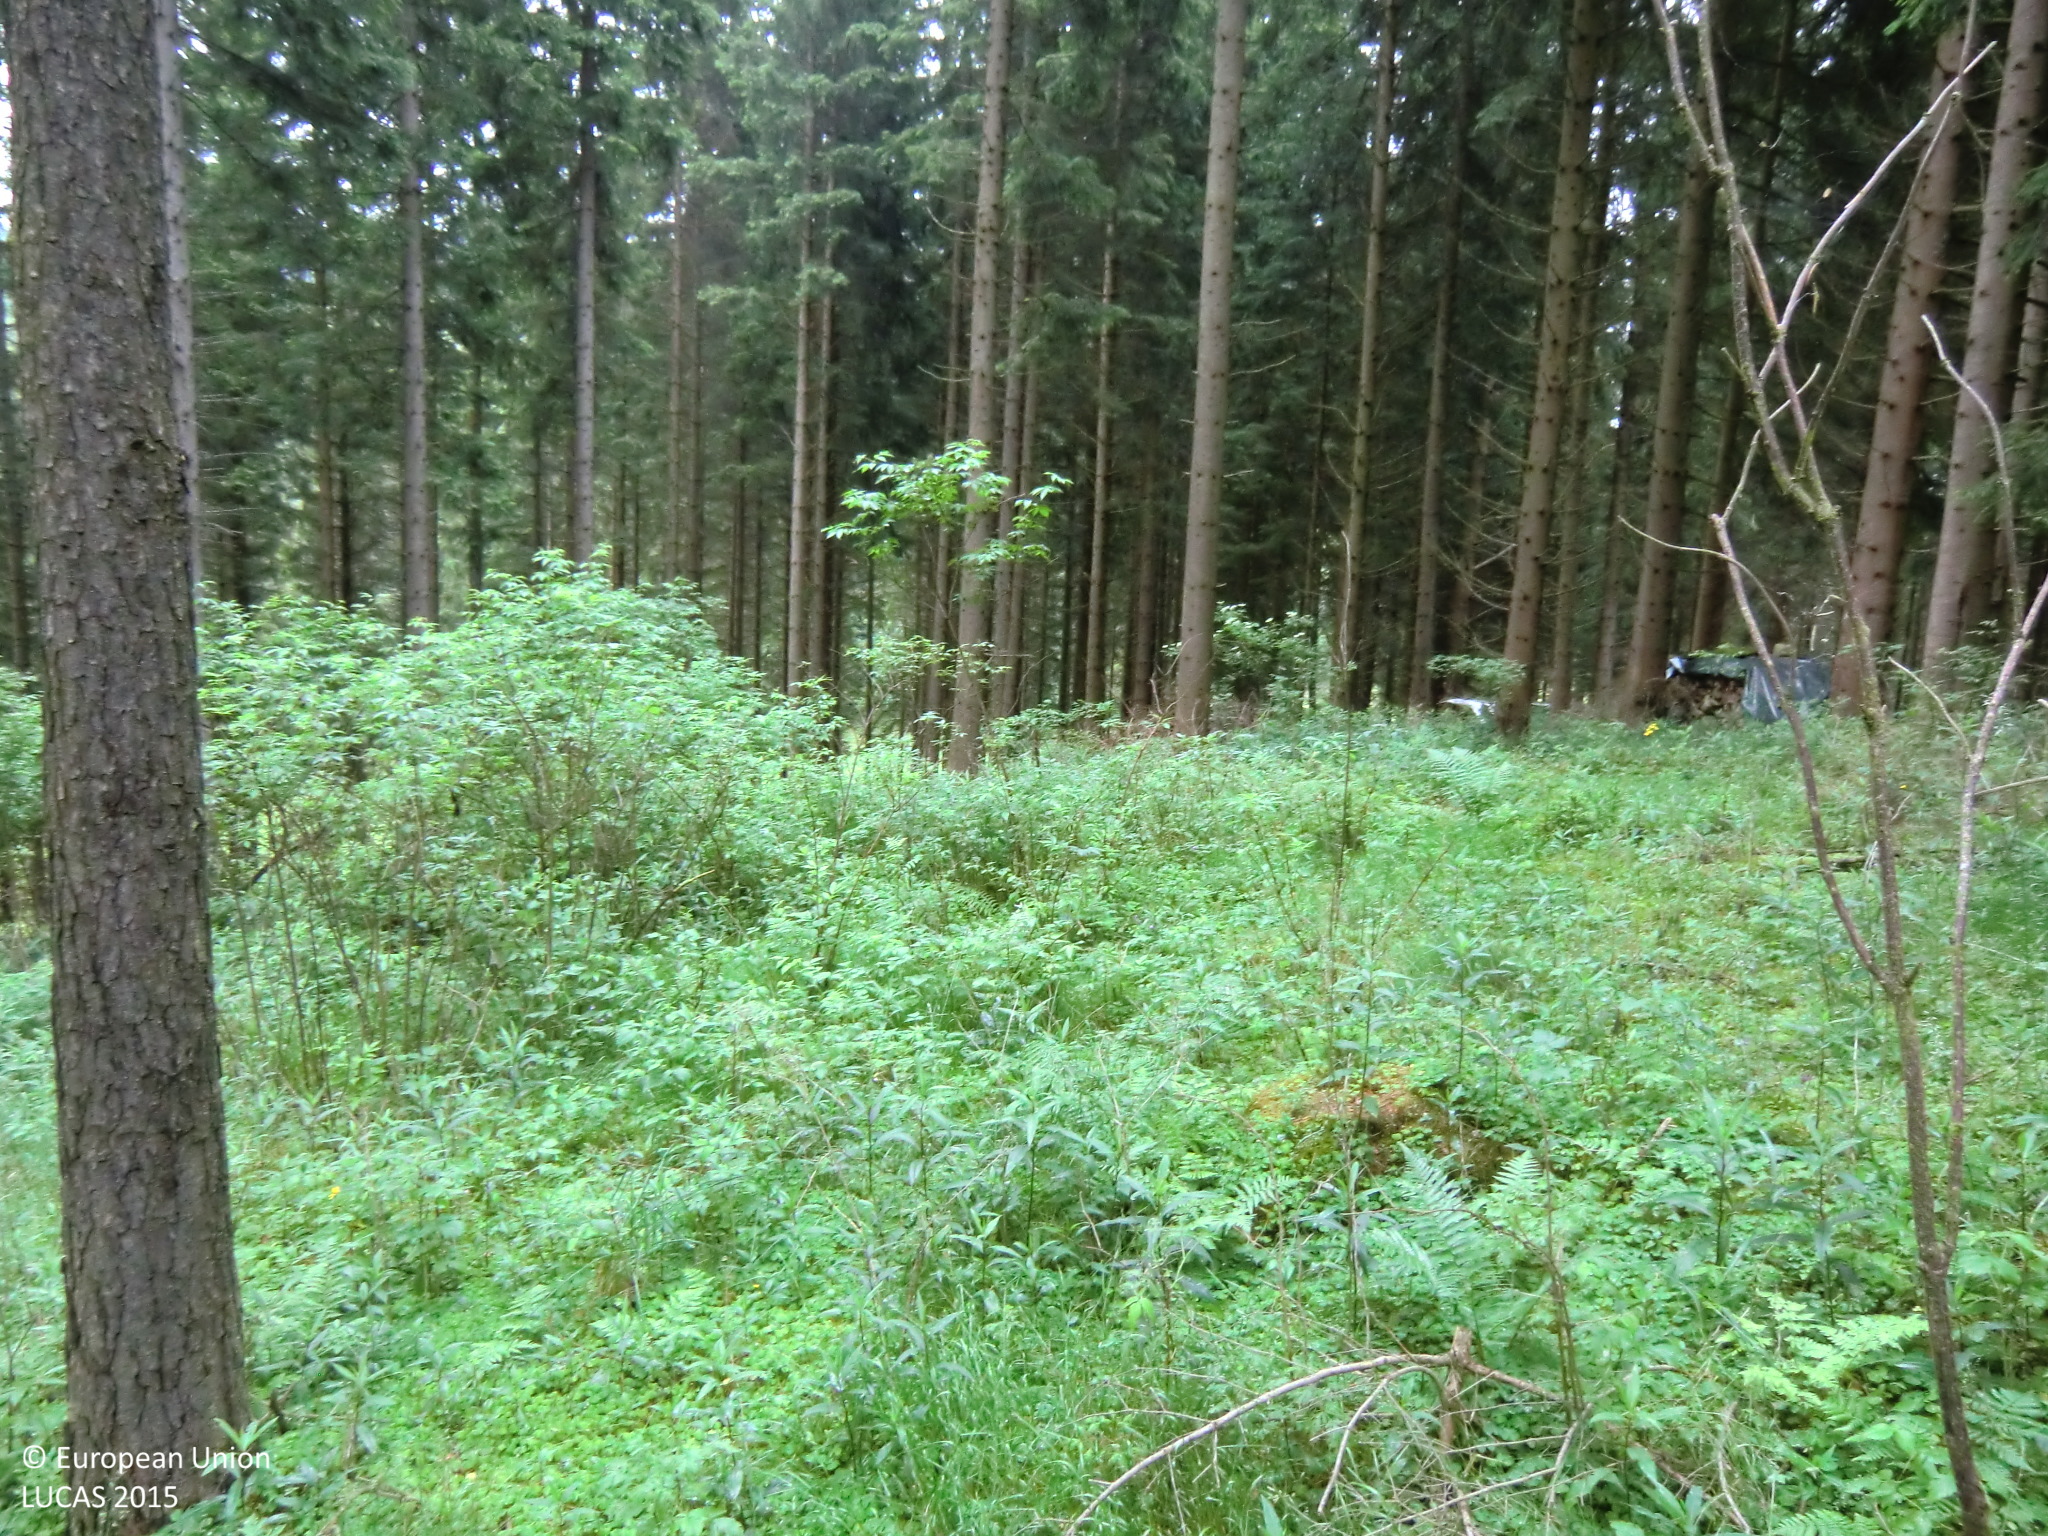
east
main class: Woodland
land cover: Spruce dominated coniferous woodland
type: hemiboreal forest and nemoral coniferous forest and mixed broadleaved-coniferous forest
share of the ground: > 75 %
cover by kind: coniferous forest trees 75 %, herbaceous plants 15 %, shrubs 10 %
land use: Forestry
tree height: > 5 m
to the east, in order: Spruce dominated coniferous woodland; Tracks; Spruce dominated coniferous woodland; Grassland without tree/shrub cover; Rivers and streams; Grassland without tree/shrub cover; Tracks; Spruce dominated mixed woodland; Tracks; Spruce dominated mixed woodland; Rivers and streams; Spruce dominated mixed woodland
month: June
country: AT
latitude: 48.4806
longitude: 14.7767
